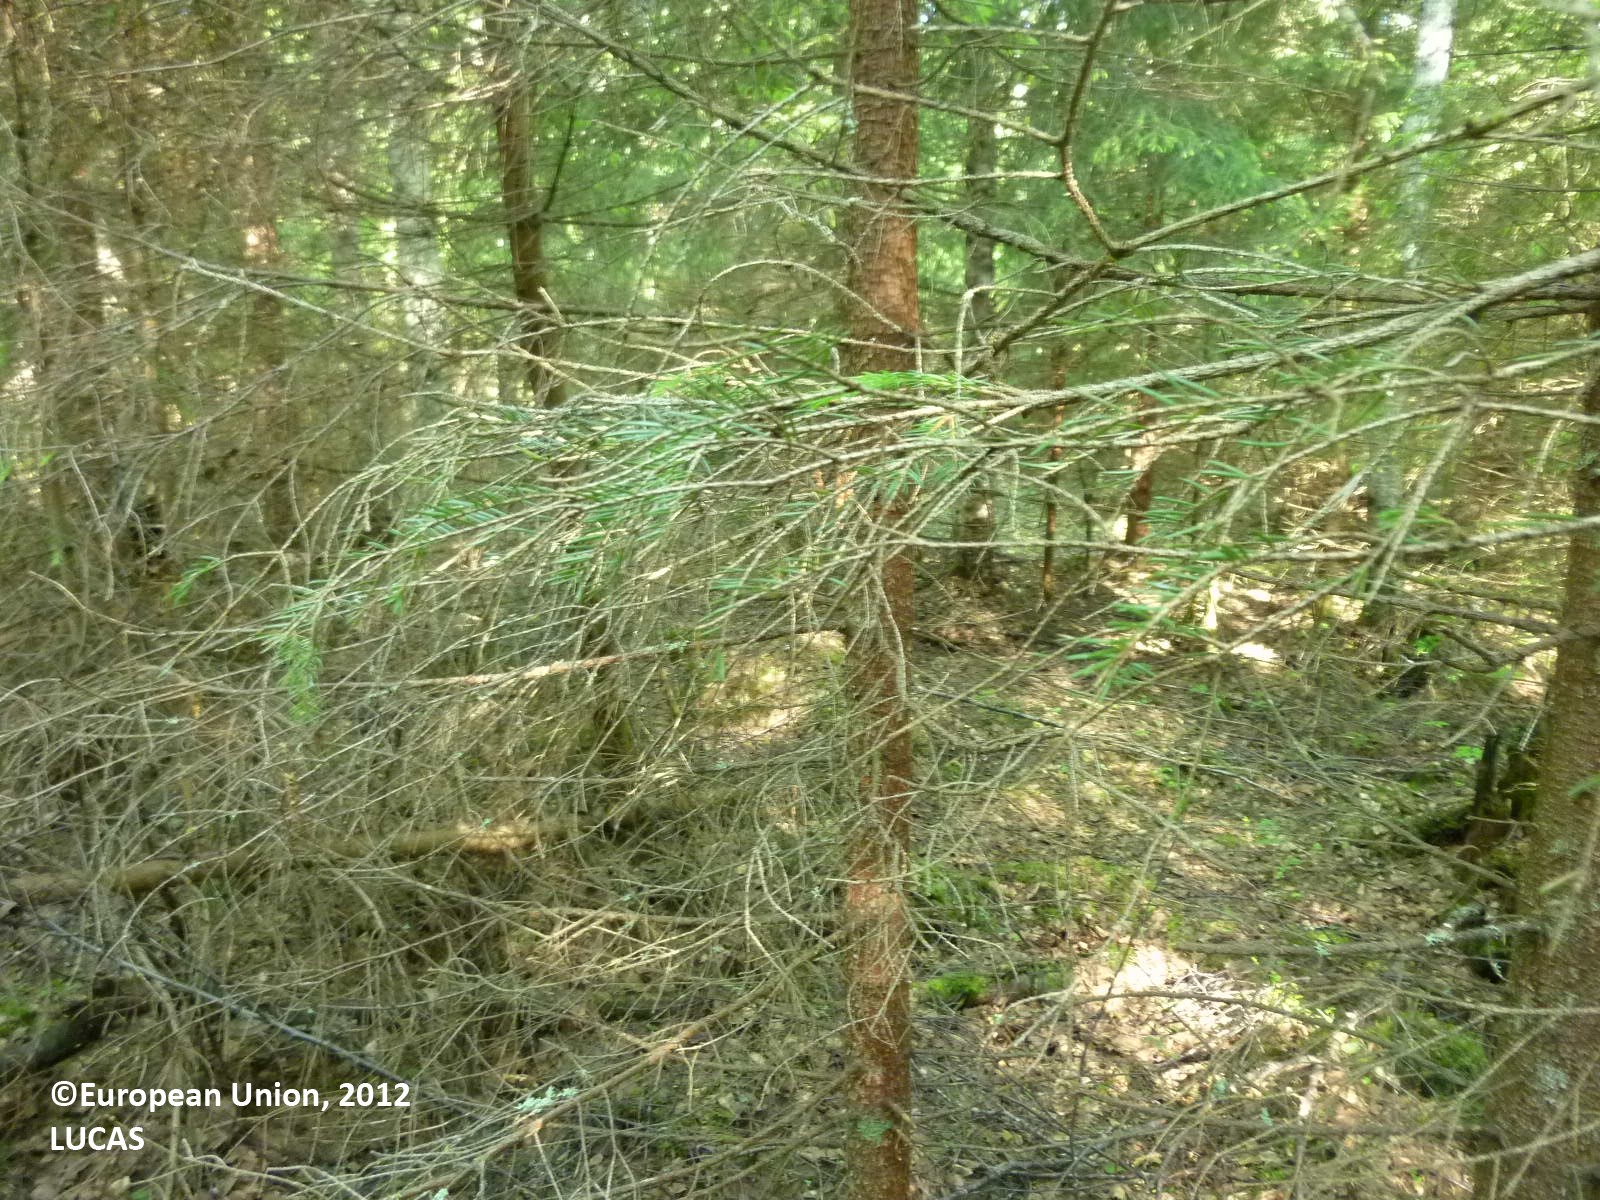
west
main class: Woodland
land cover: Spruce dominated mixed woodland
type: boreal forest
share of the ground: > 75 %
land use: Forestry
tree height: > 5 m
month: June
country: FI
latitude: 61.6604
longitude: 22.1622
